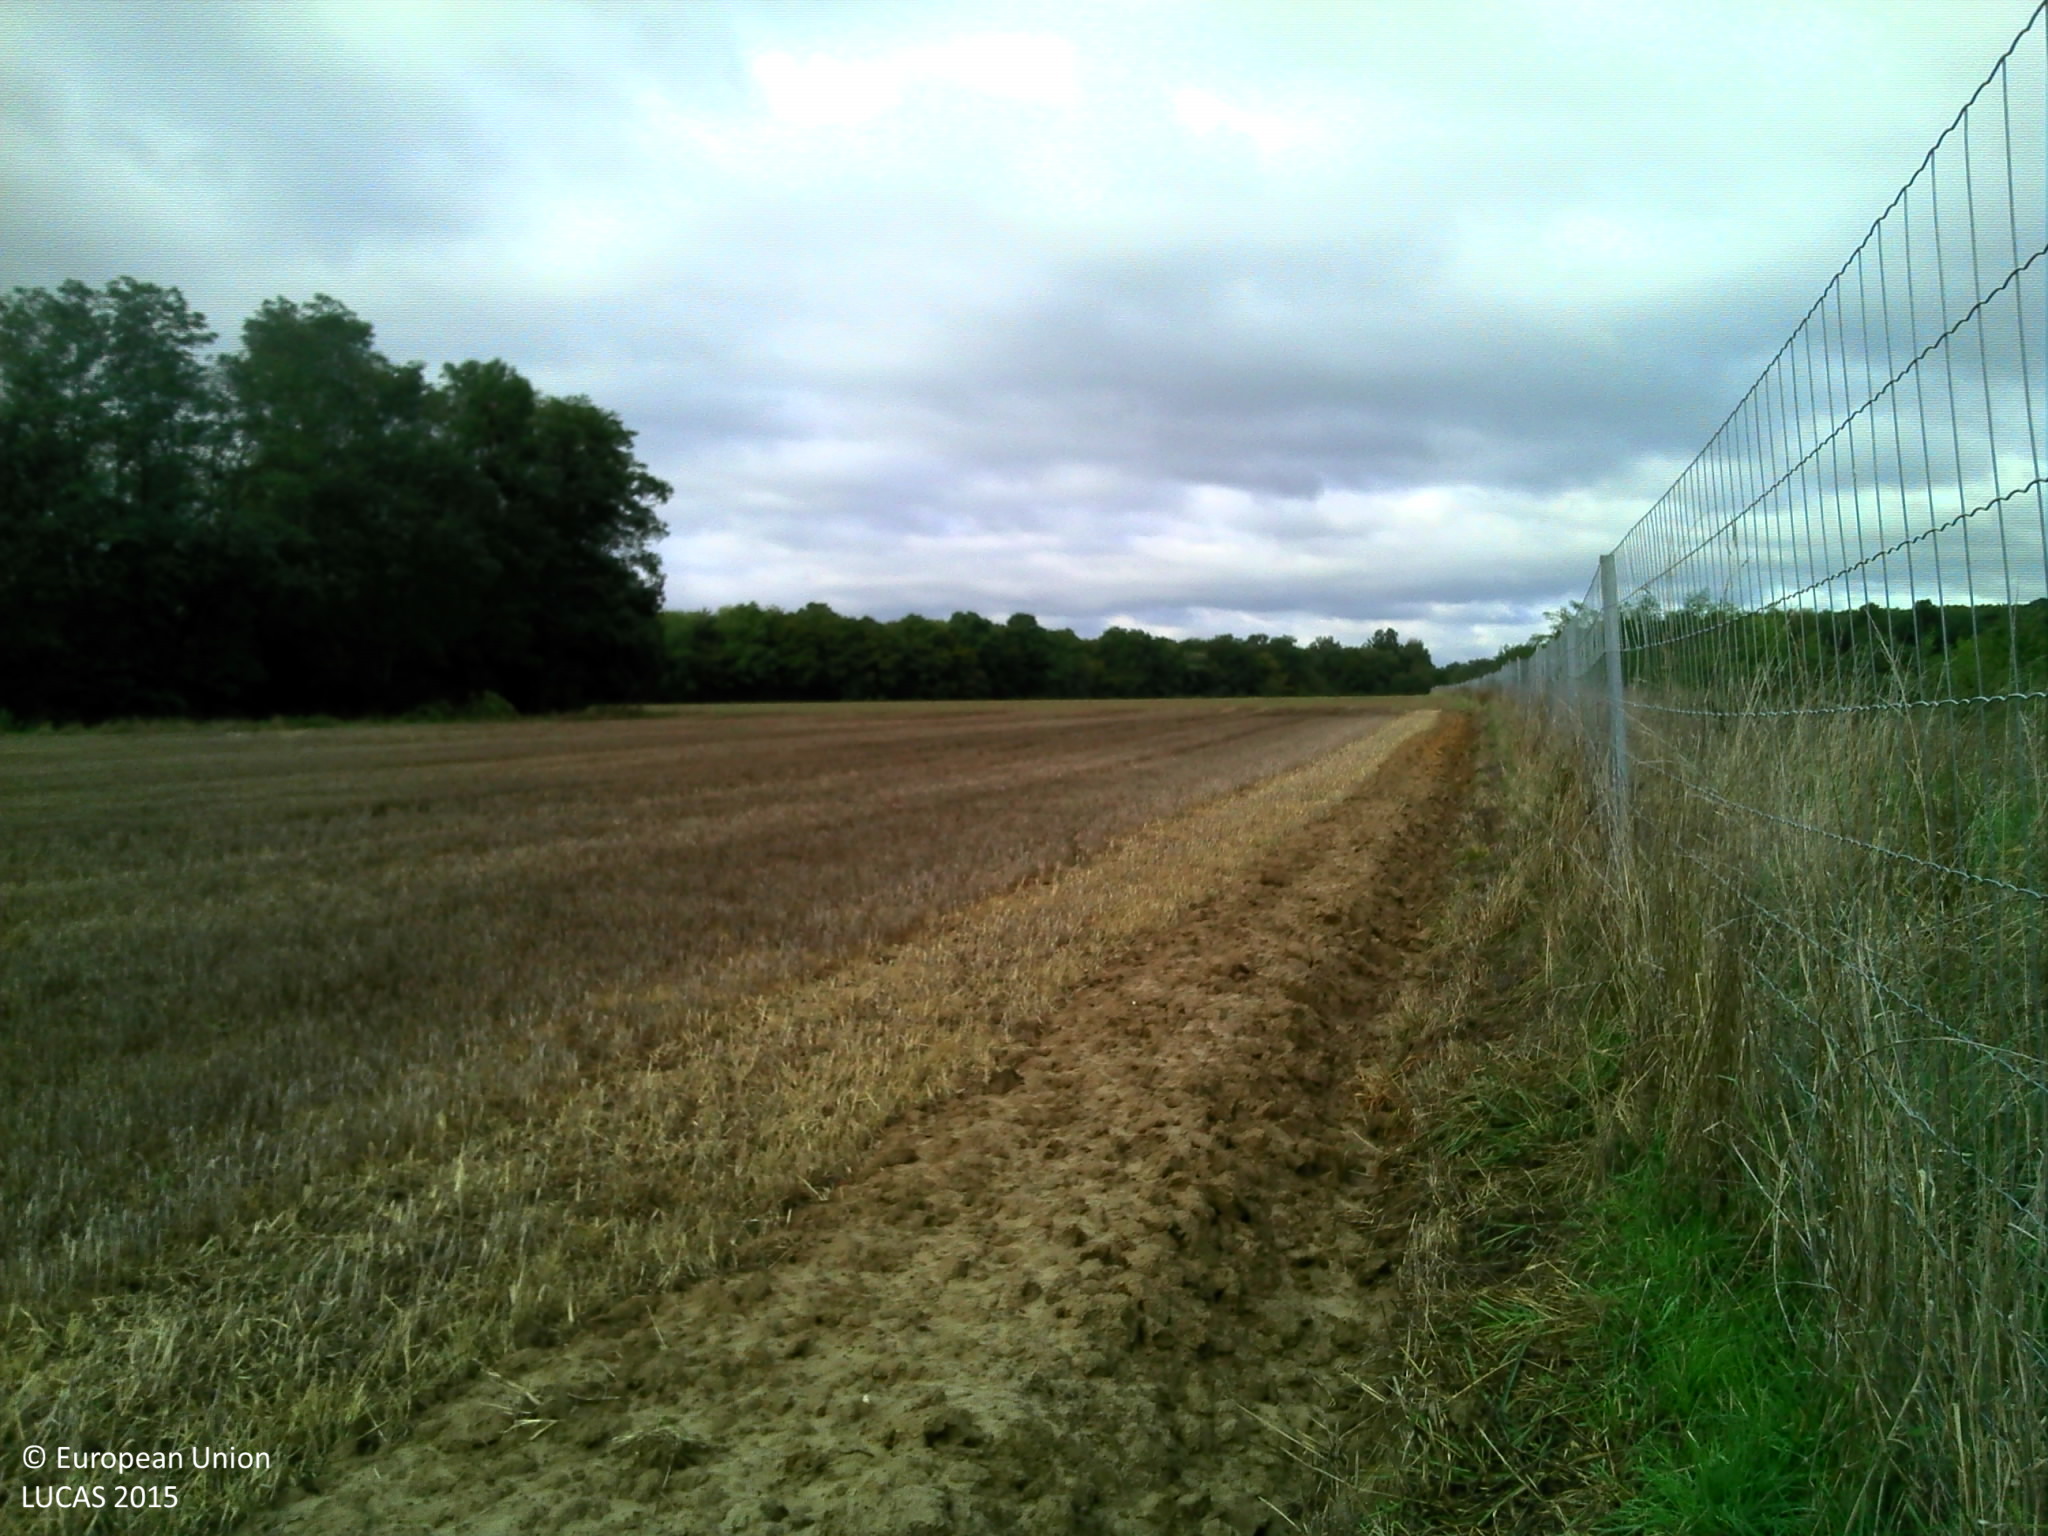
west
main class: Grassland
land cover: Grassland without tree/shrub cover
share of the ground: > 75 %
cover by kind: herbaceous plants 95 %, shrubs 5 %
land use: Road transport
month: September
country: FR
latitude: 47.0455
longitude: 4.9861
